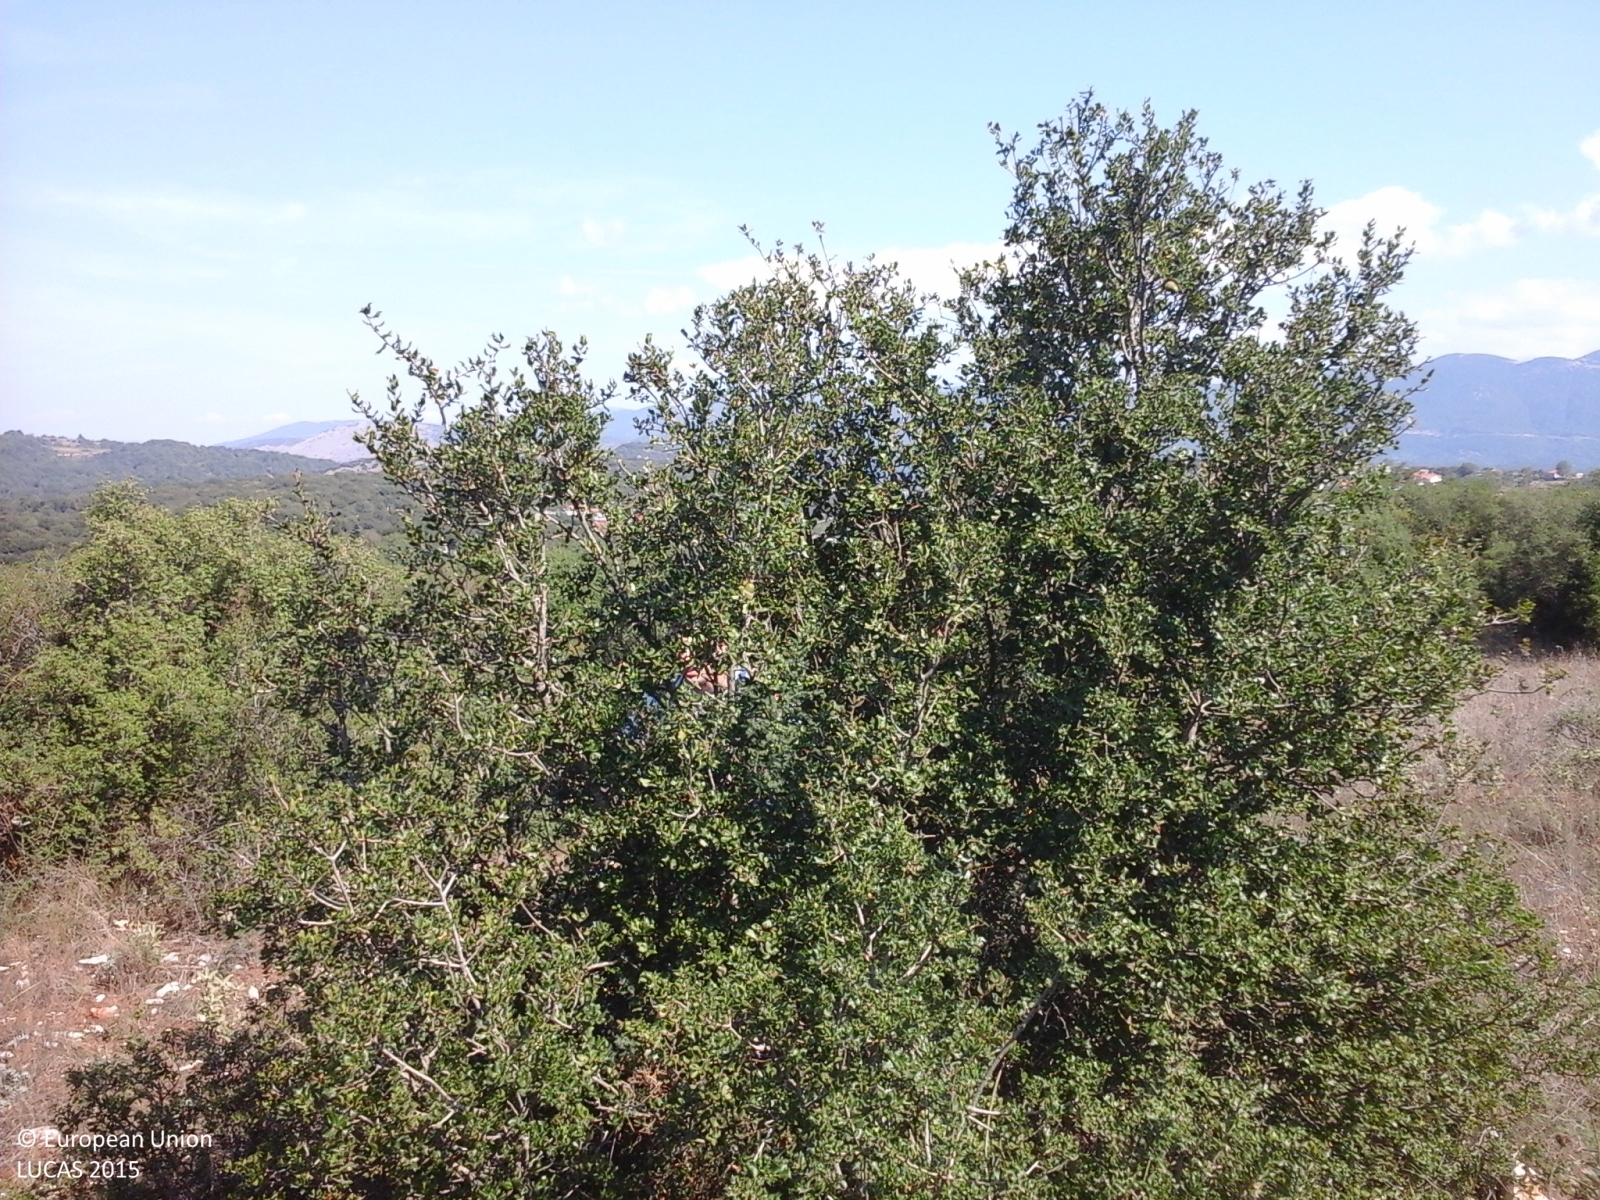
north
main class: Shrubland
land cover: Shrubland with sparse tree cover
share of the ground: 50 - 75 %
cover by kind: shrubs 65 %, herbaceous plants 20 %, unconsolidated bare surface 10 %, broadleaved forest trees 5 %
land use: Semi-natural and natural areas not in use
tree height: < 5 m
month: September
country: GR
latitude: 39.7734
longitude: 20.6844
